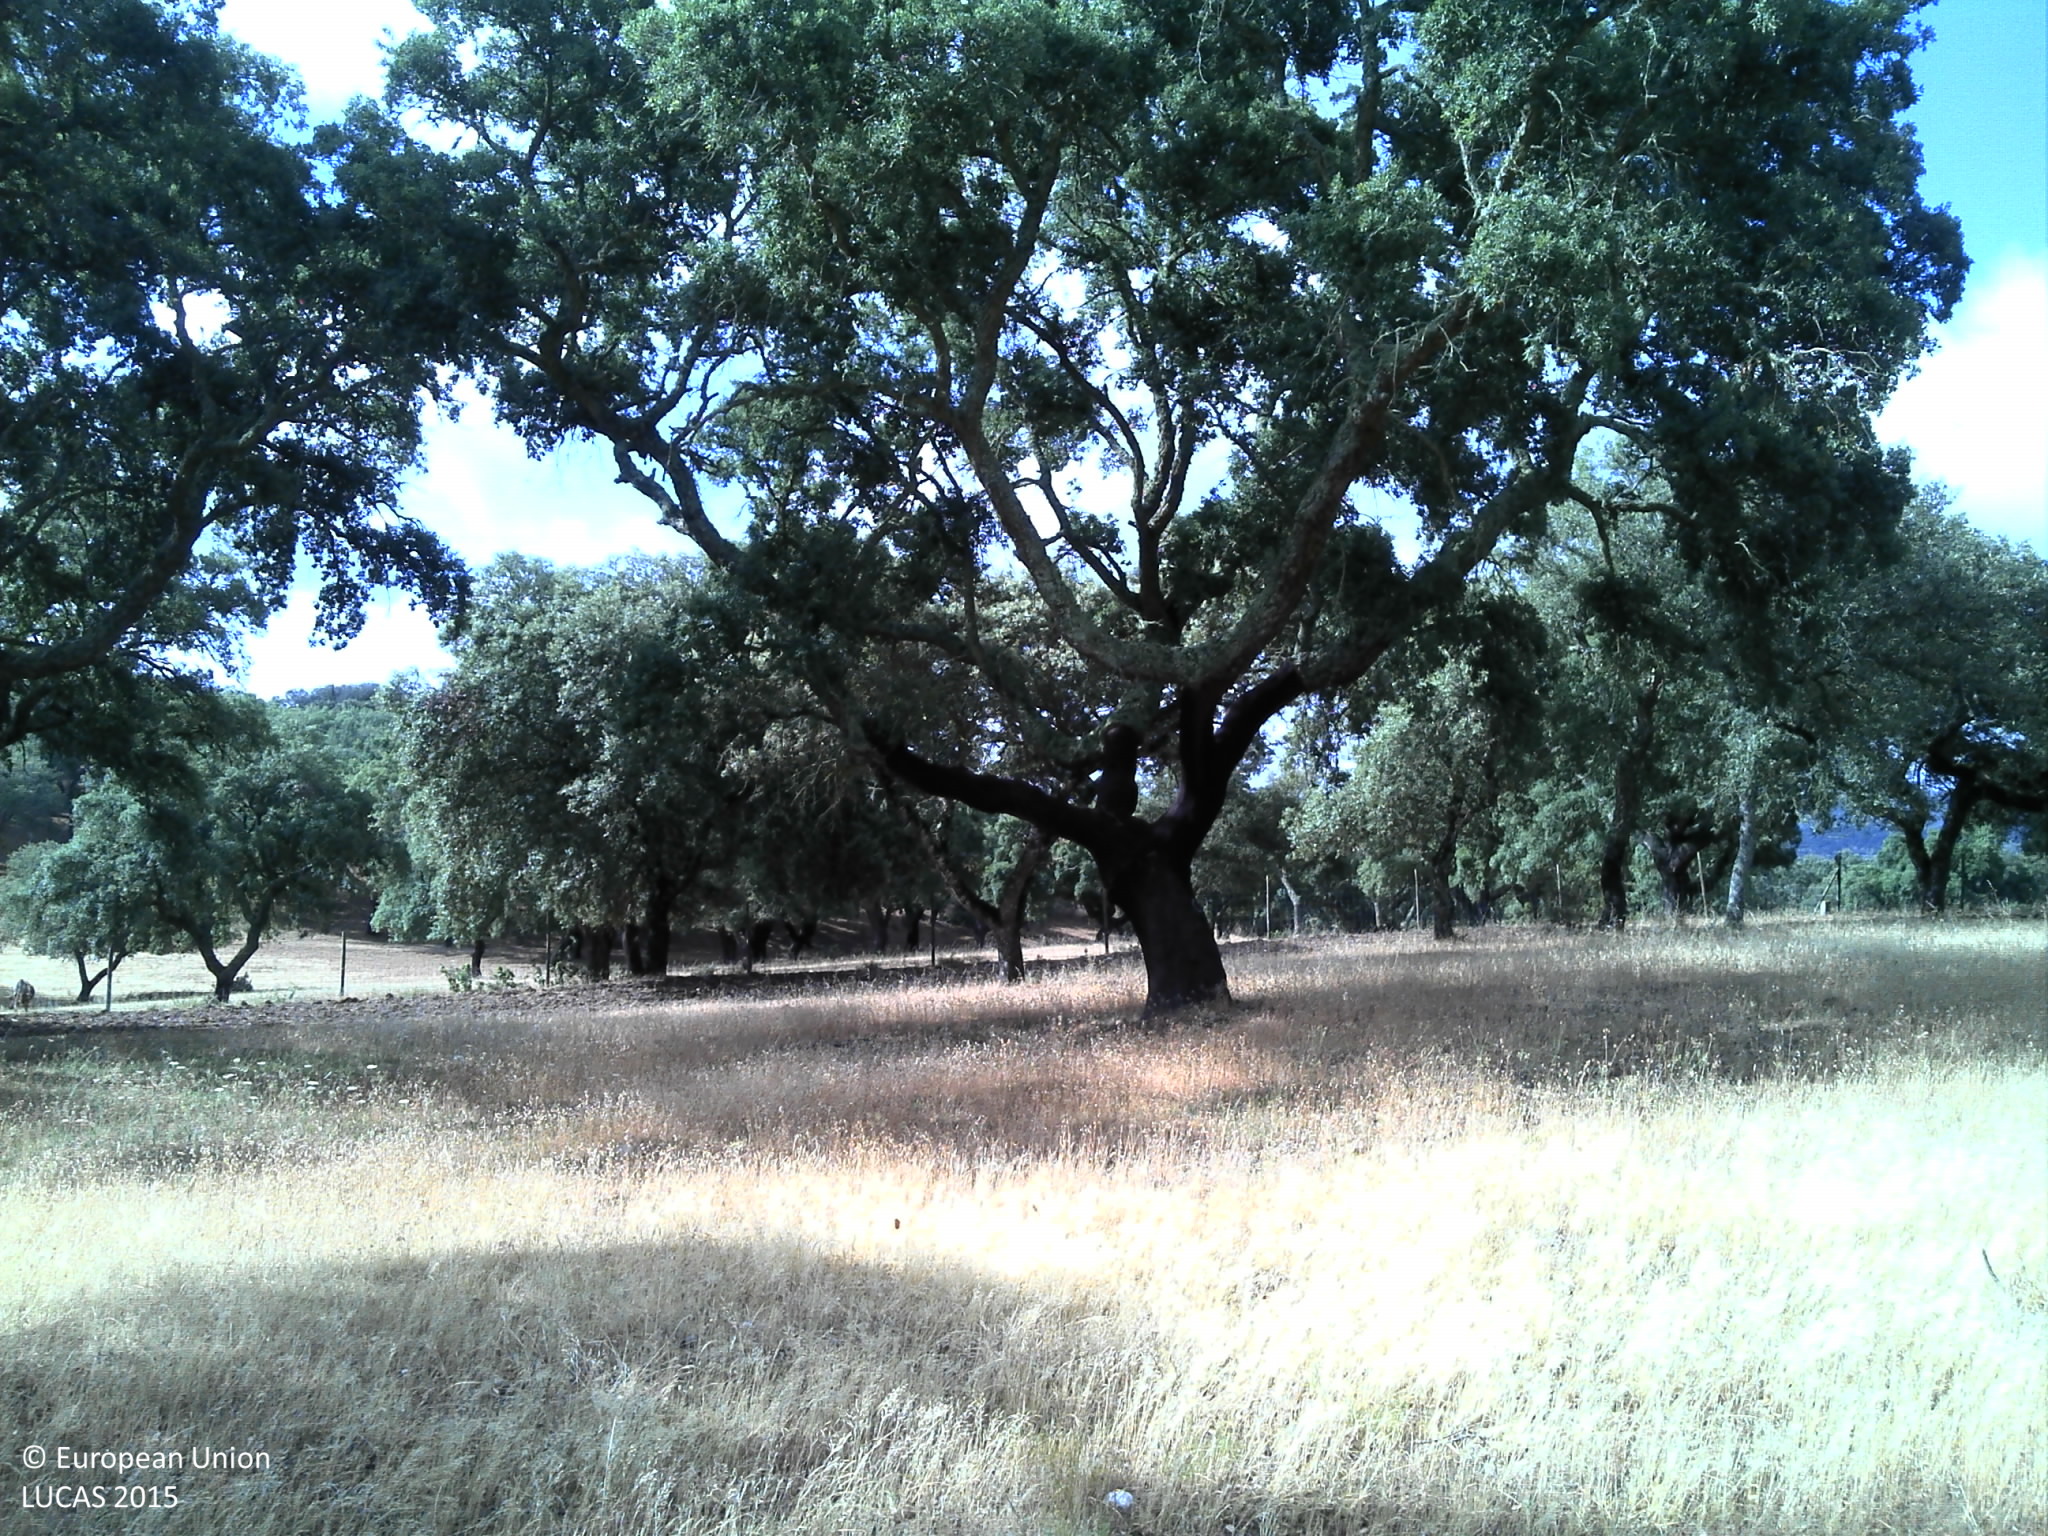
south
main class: Woodland
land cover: Broadleaved woodland
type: broadleaved evergreen forest
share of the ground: 10 - 25 %
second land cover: Spontaneously vegetated surfaces
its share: 25 - 50 %
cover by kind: herbaceous plants 50 %, unconsolidated bare surface 40 %, broadleaved forest trees 10 %
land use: Forestry
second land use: Agriculture (excluding fallow land and kitchen gardens)
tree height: > 5 m
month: June
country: PT
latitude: 38.5811
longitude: -8.0307
